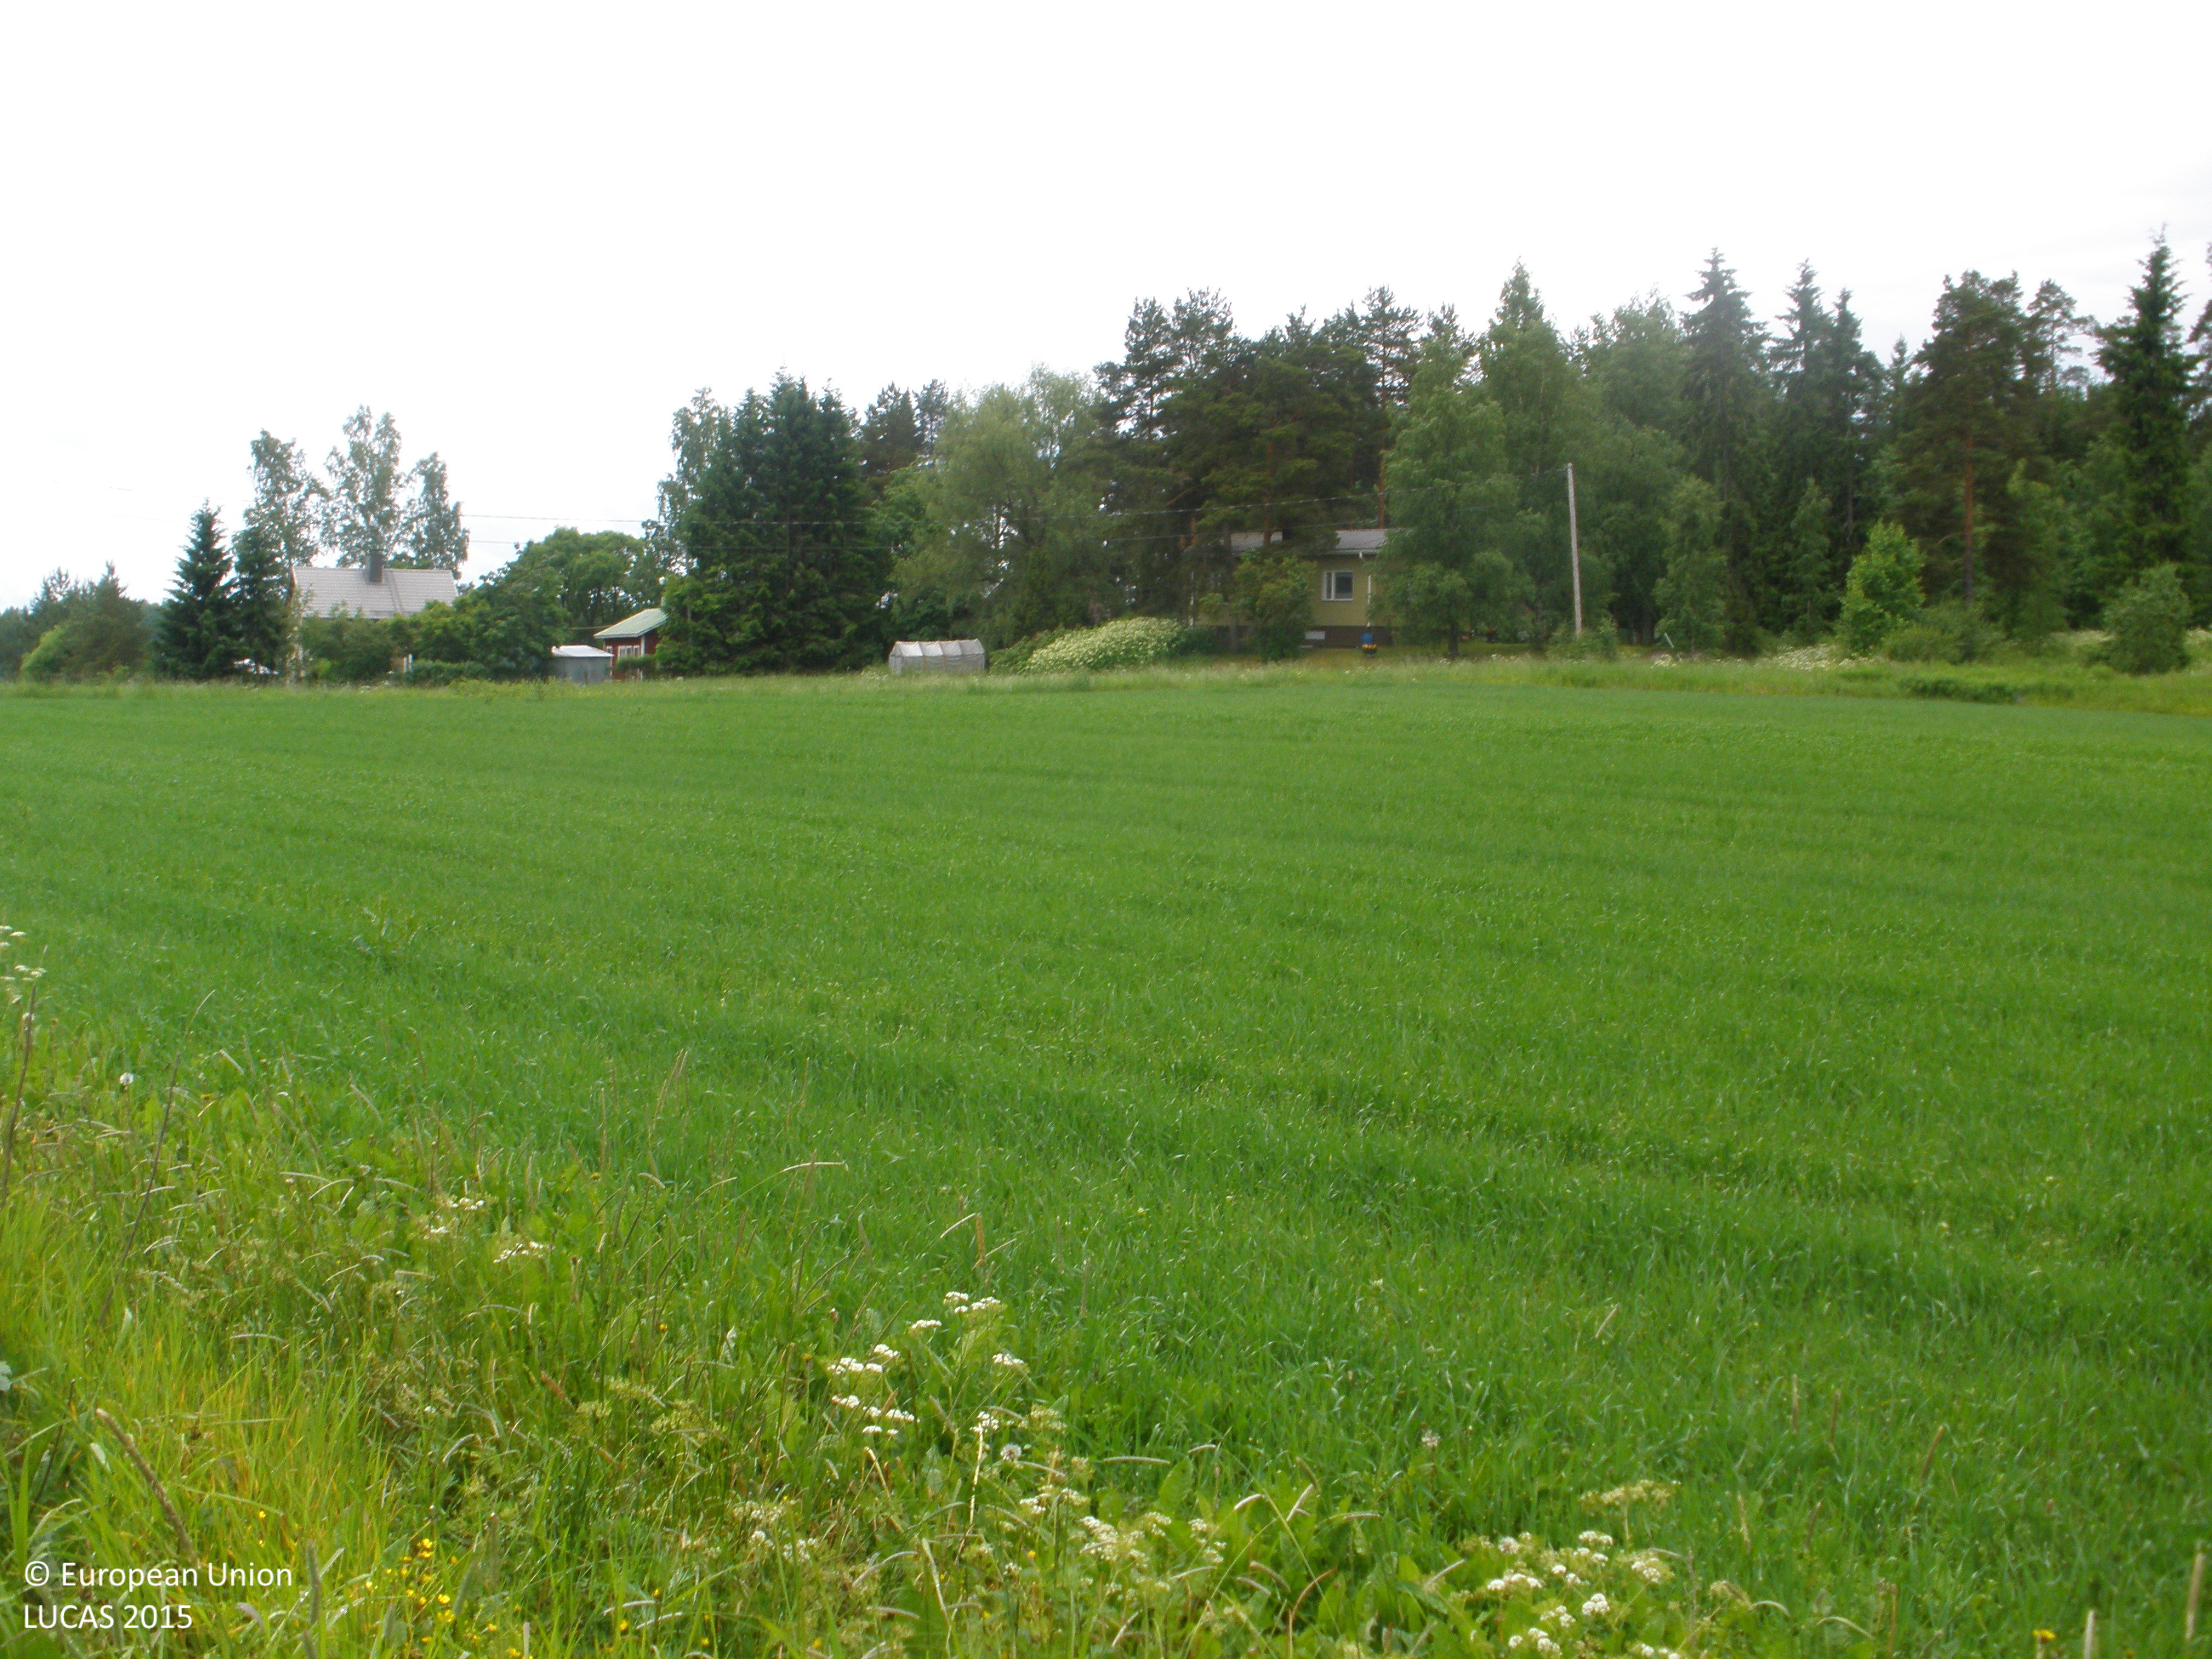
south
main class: Cropland
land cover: Barley
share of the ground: > 75 %
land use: Agriculture (excluding fallow land and kitchen gardens)
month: June
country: FI
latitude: 61.1422
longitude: 23.8518
